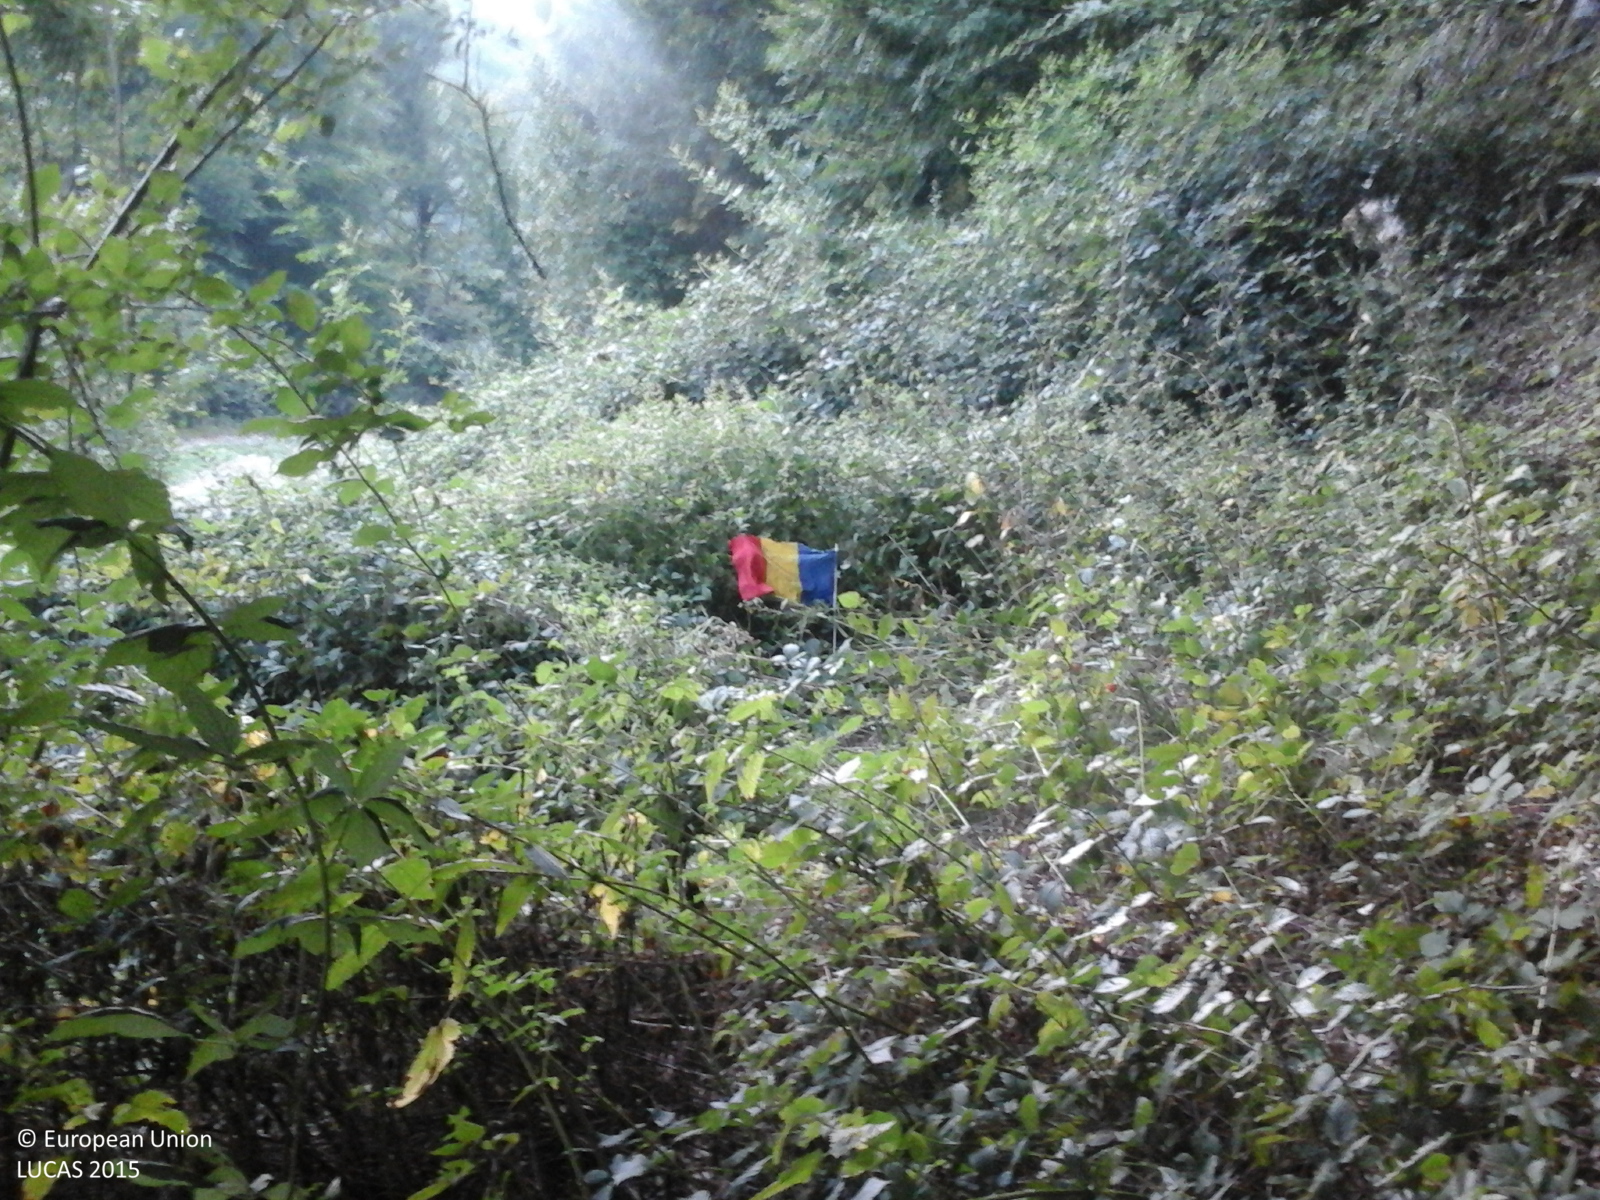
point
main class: Grassland
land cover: Spontaneously vegetated surfaces
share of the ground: > 75 %
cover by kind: herbaceous plants 100 %
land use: Forestry
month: August
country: RO
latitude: 46.4636
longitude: 22.2488
